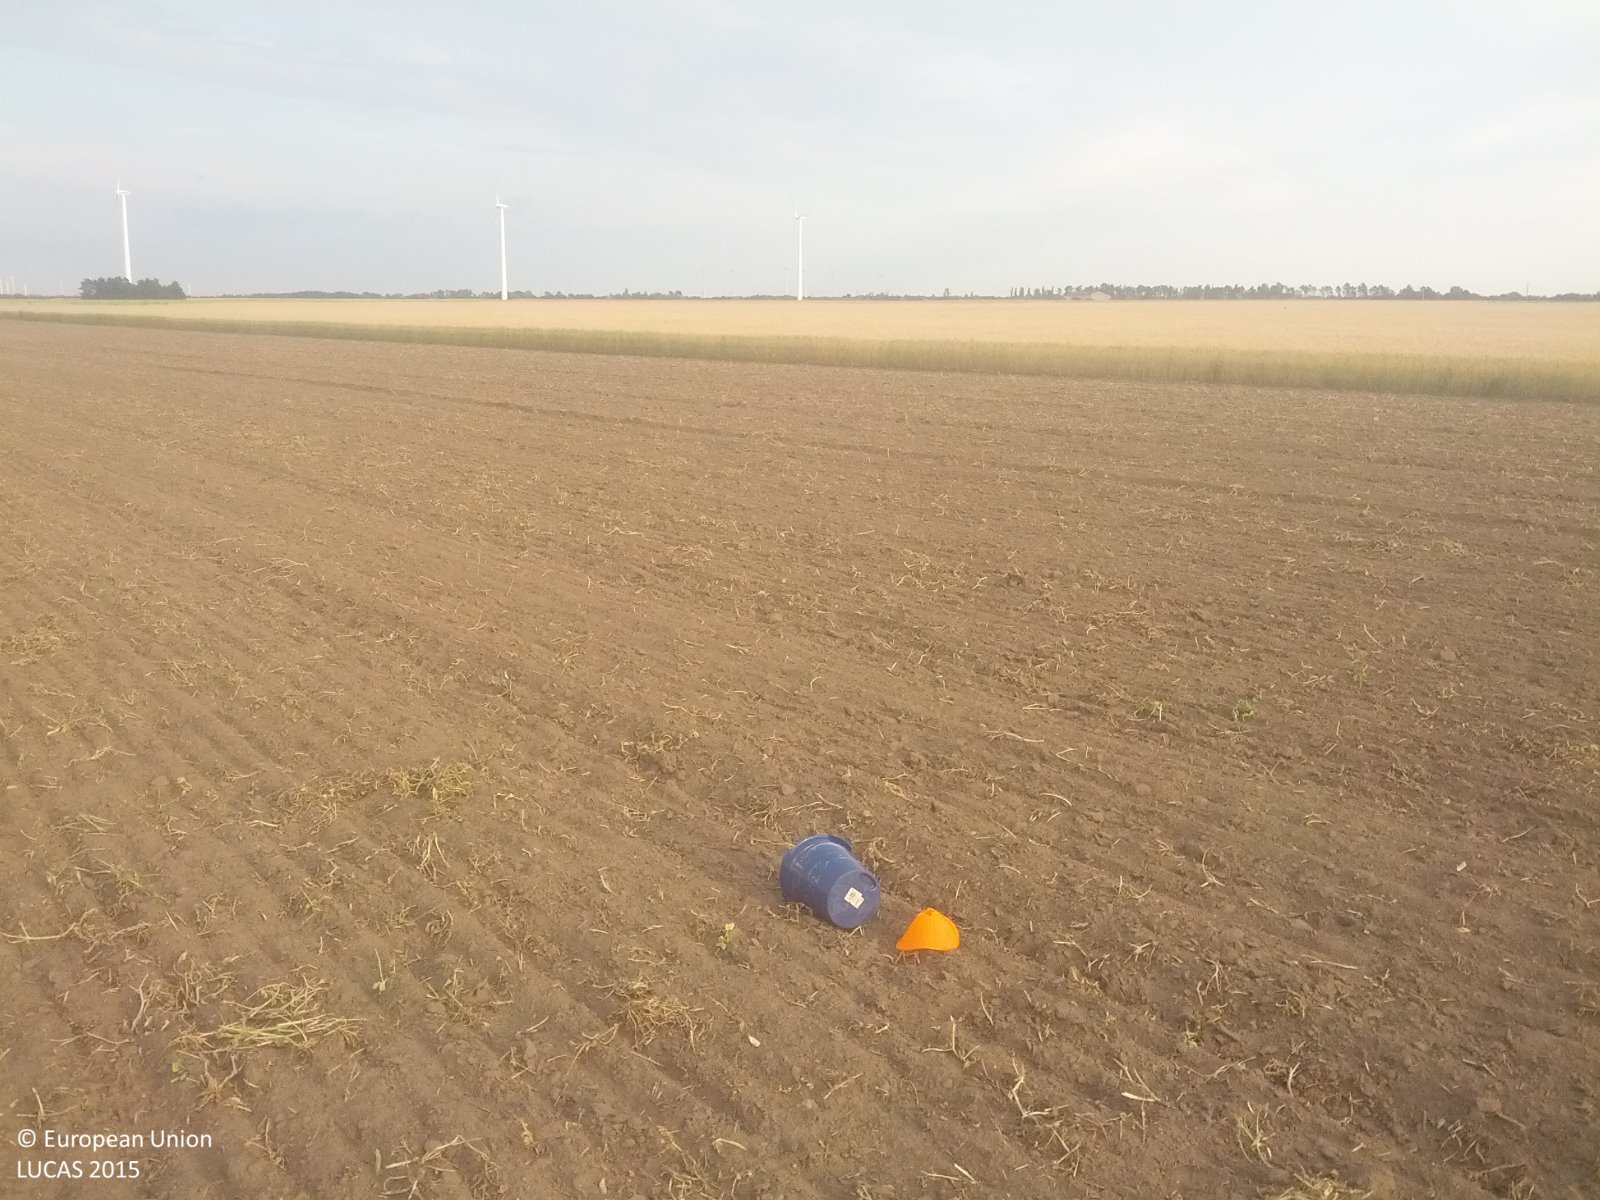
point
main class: Cropland
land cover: Dry pulses
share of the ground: < 10 %
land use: Agriculture (excluding fallow land and kitchen gardens)
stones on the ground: 10 - 25 %
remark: Harvested field
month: June
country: AT
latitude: 48.2983
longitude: 16.5708
